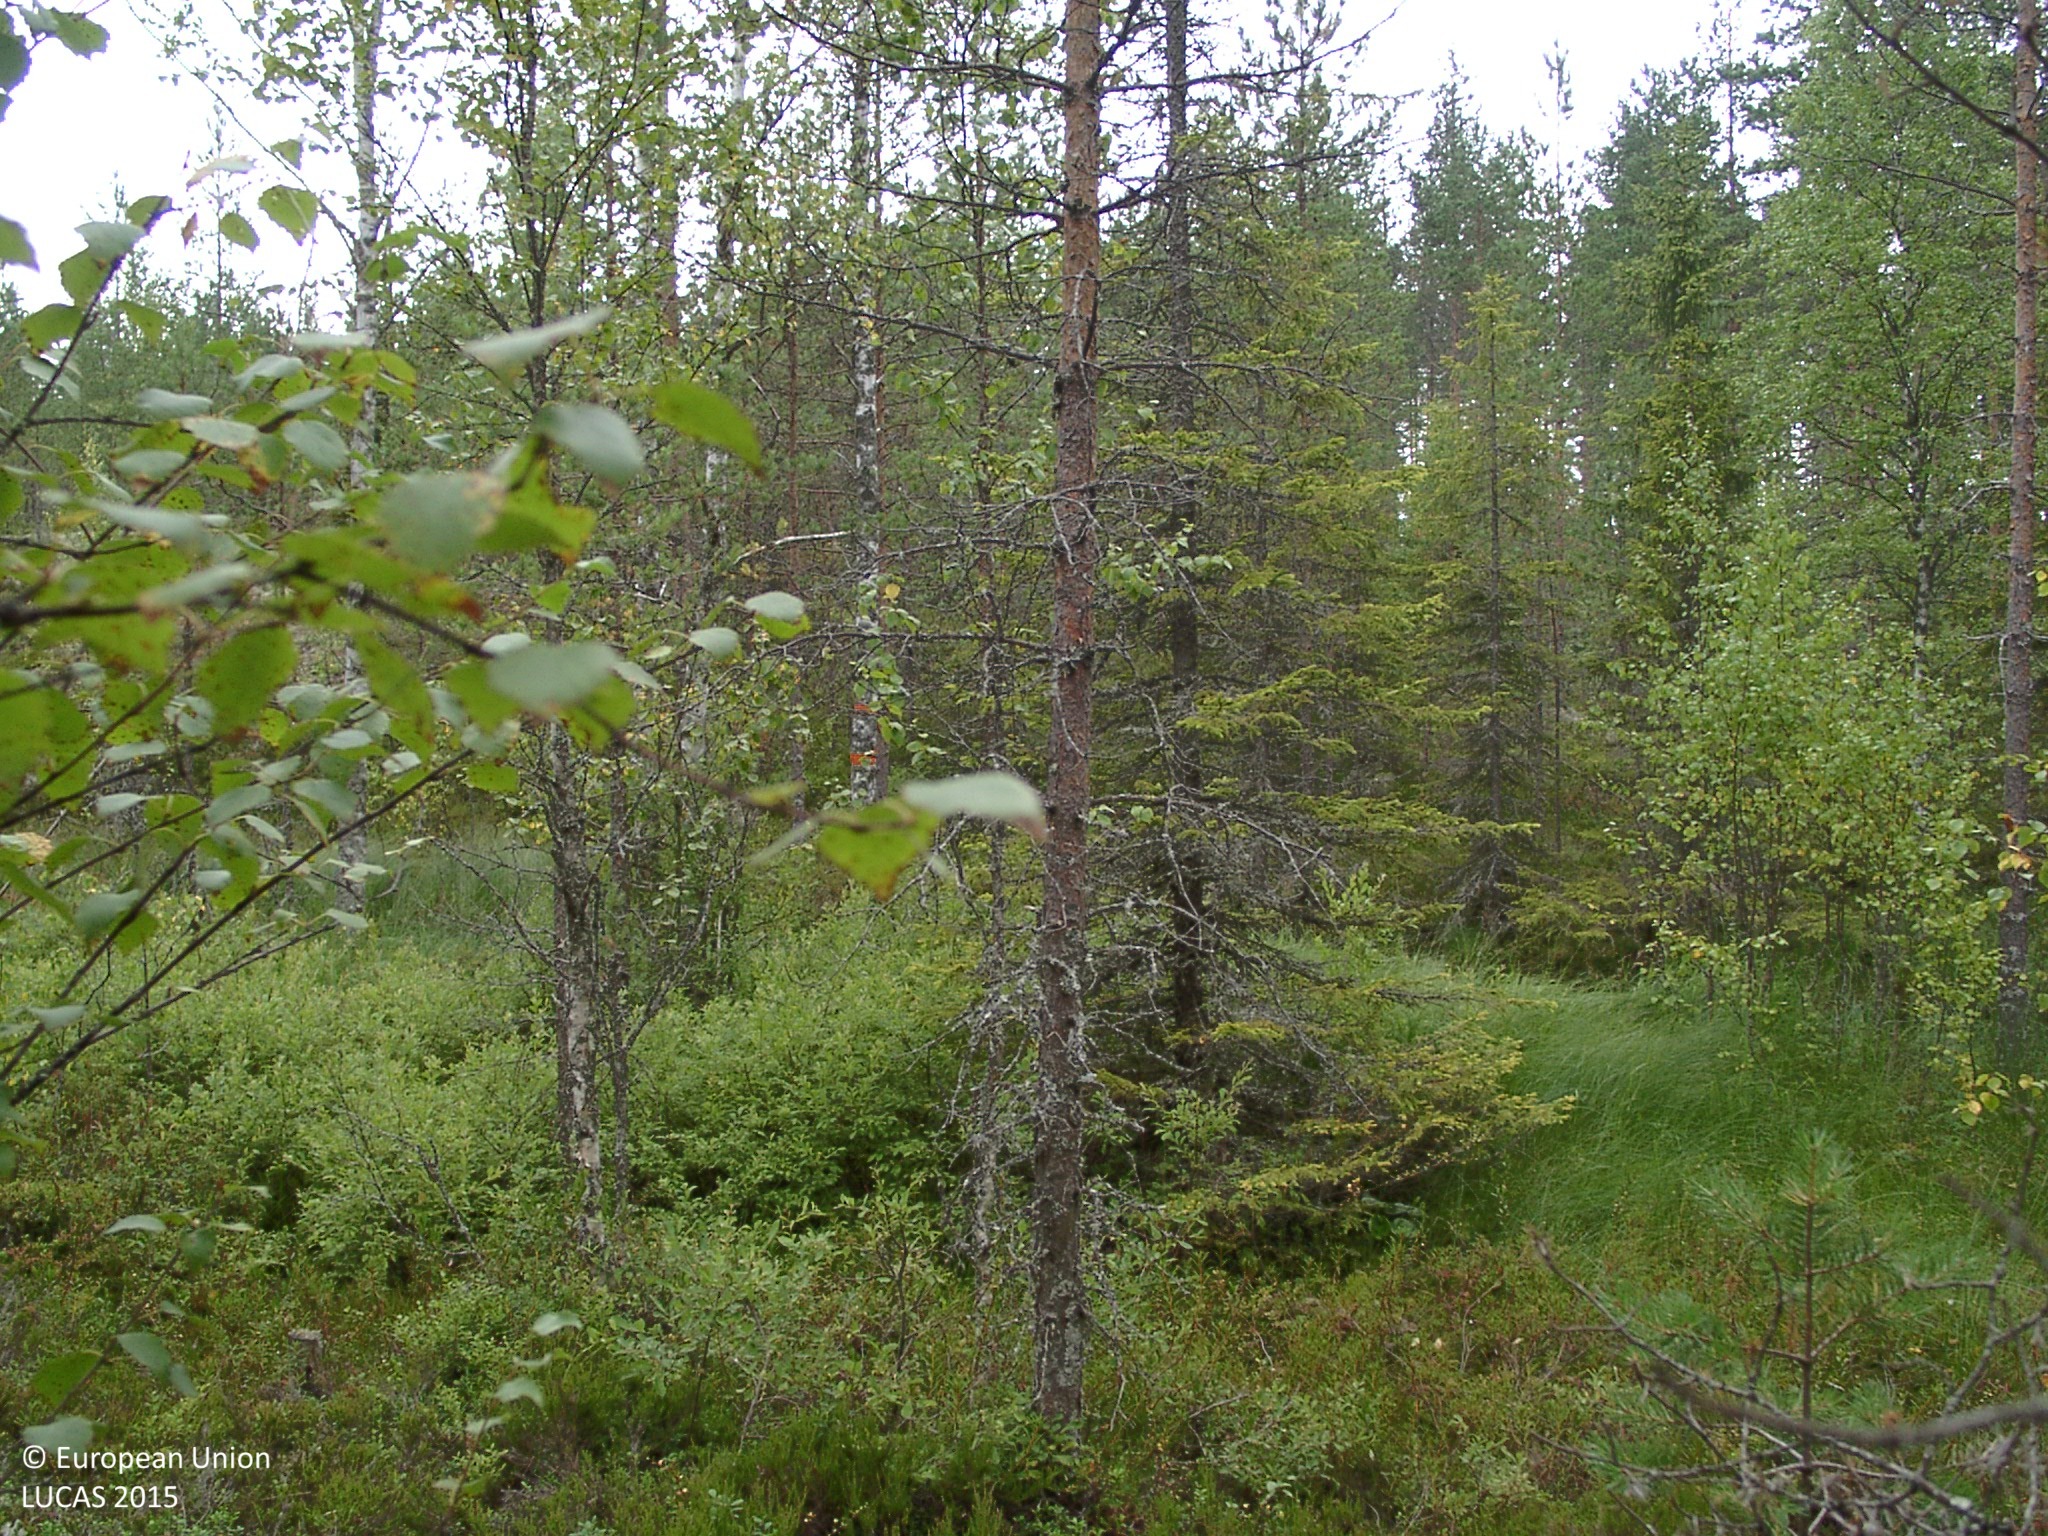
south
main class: Woodland
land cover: Other mixed woodland
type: boreal forest
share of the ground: 25 - 50 %
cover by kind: shrubs 45 %, coniferous forest trees 30 %, lichens and mosses 15 %, broadleaved forest trees 10 %
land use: Forestry
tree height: < 5 m
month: August
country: FI
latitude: 62.6546
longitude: 24.5488
